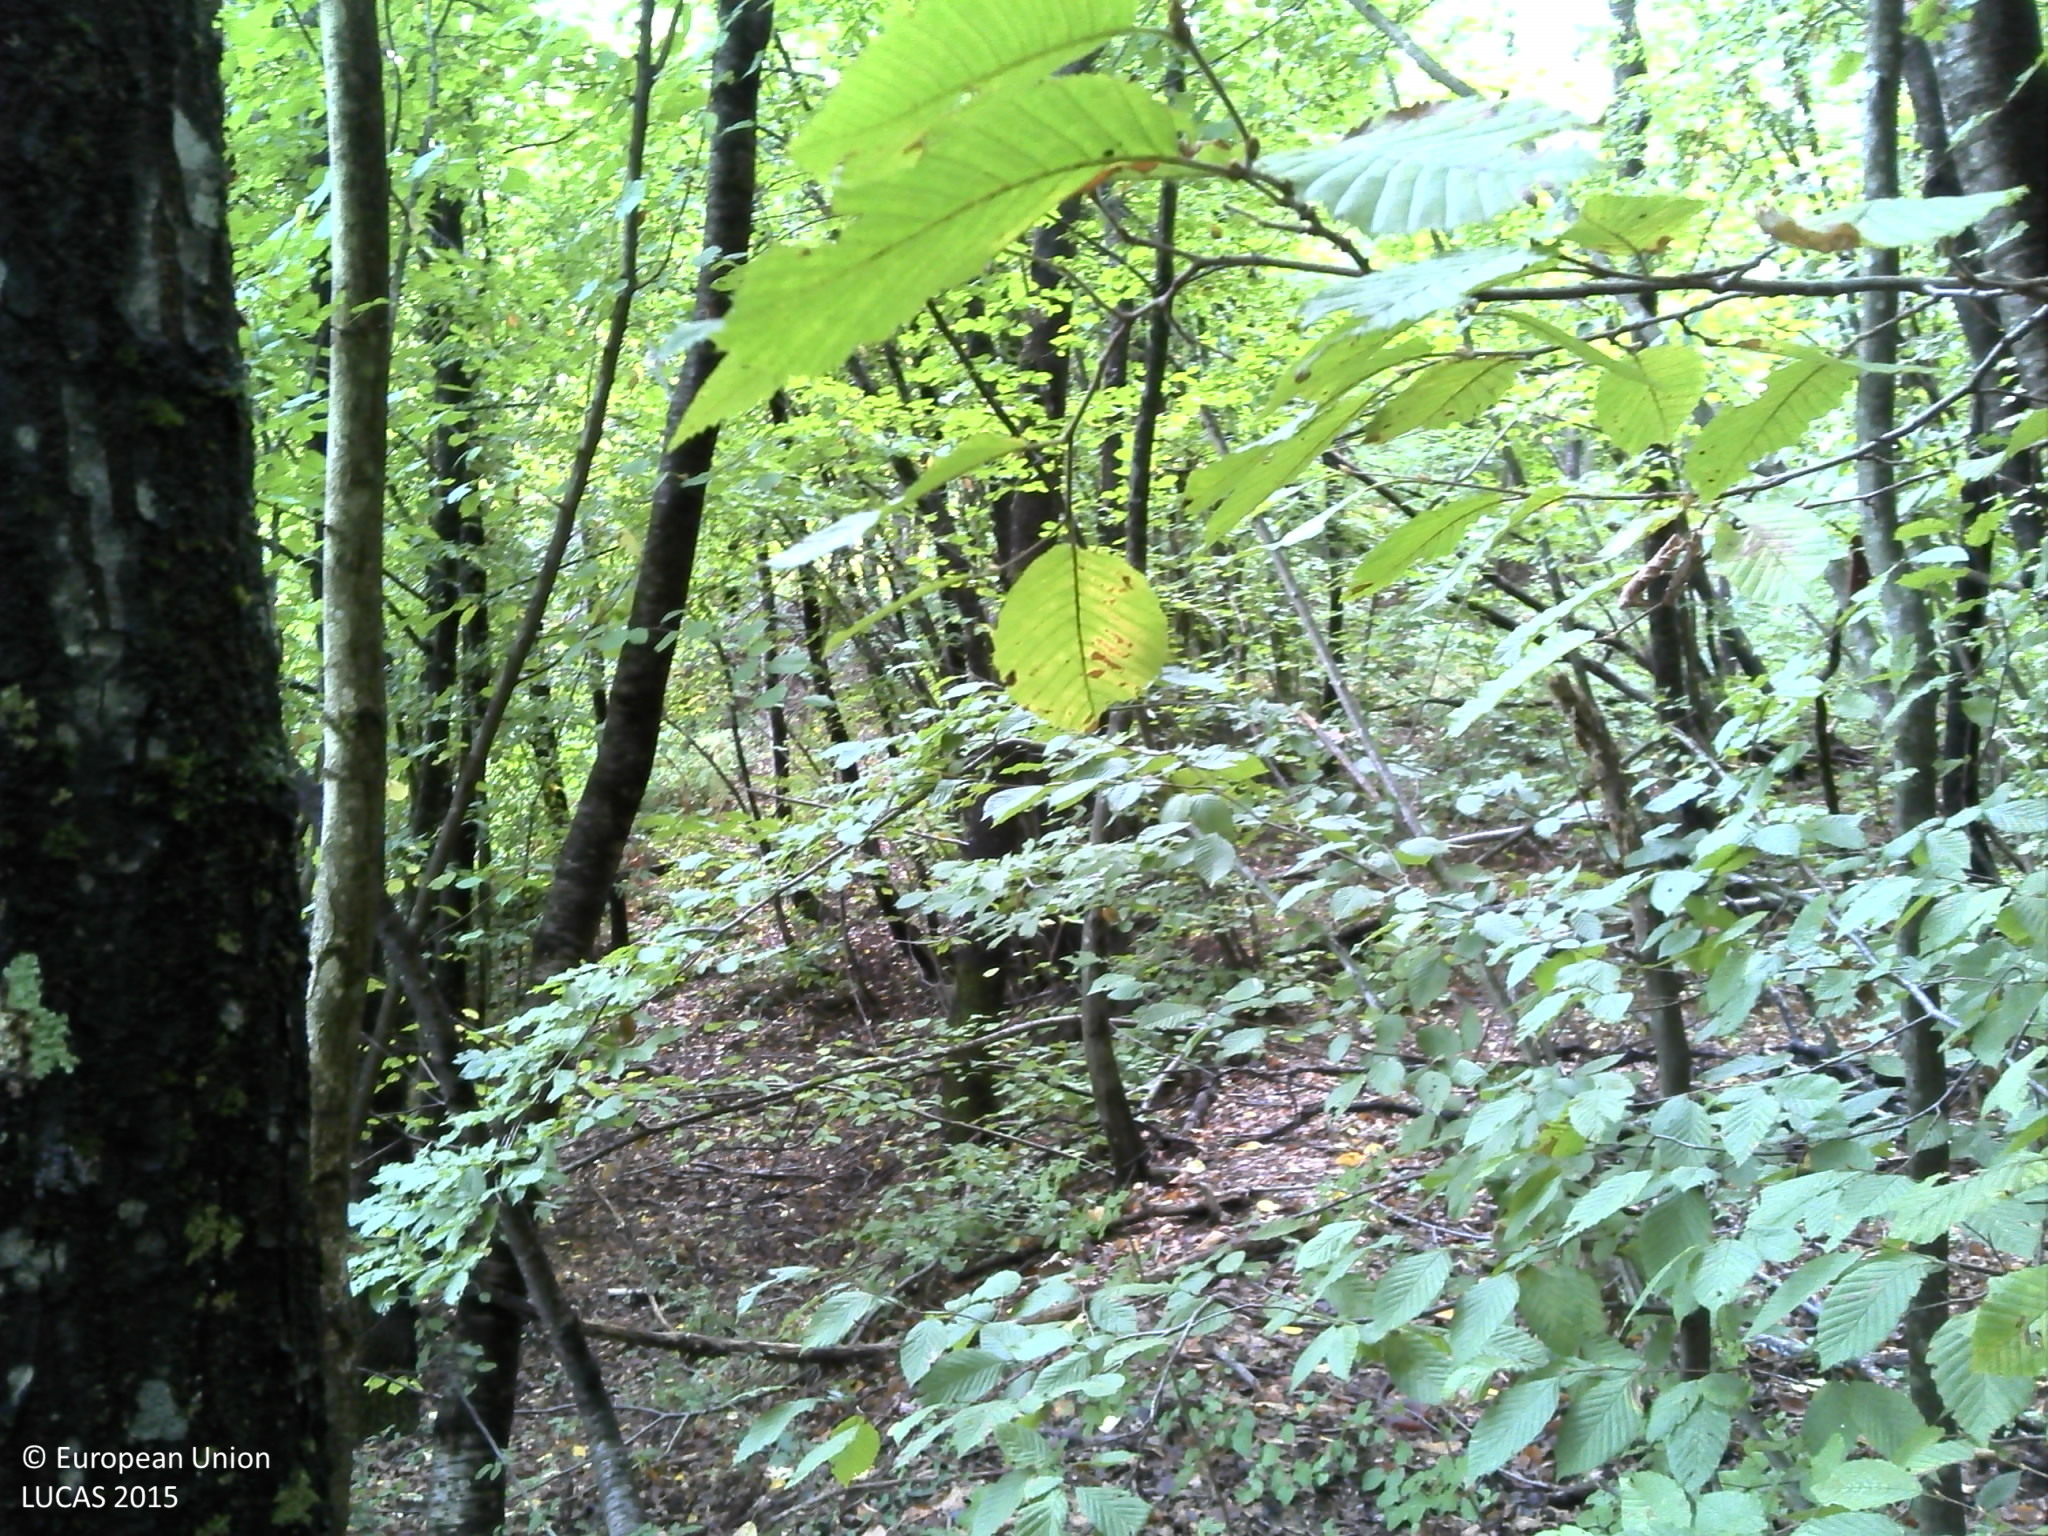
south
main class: Woodland
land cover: Broadleaved woodland
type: acidophilous oak and oak-birch forest
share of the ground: > 75 %
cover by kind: broadleaved forest trees 100 %
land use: Forestry
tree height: > 5 m
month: September
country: HR
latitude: 45.3010
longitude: 15.2623
